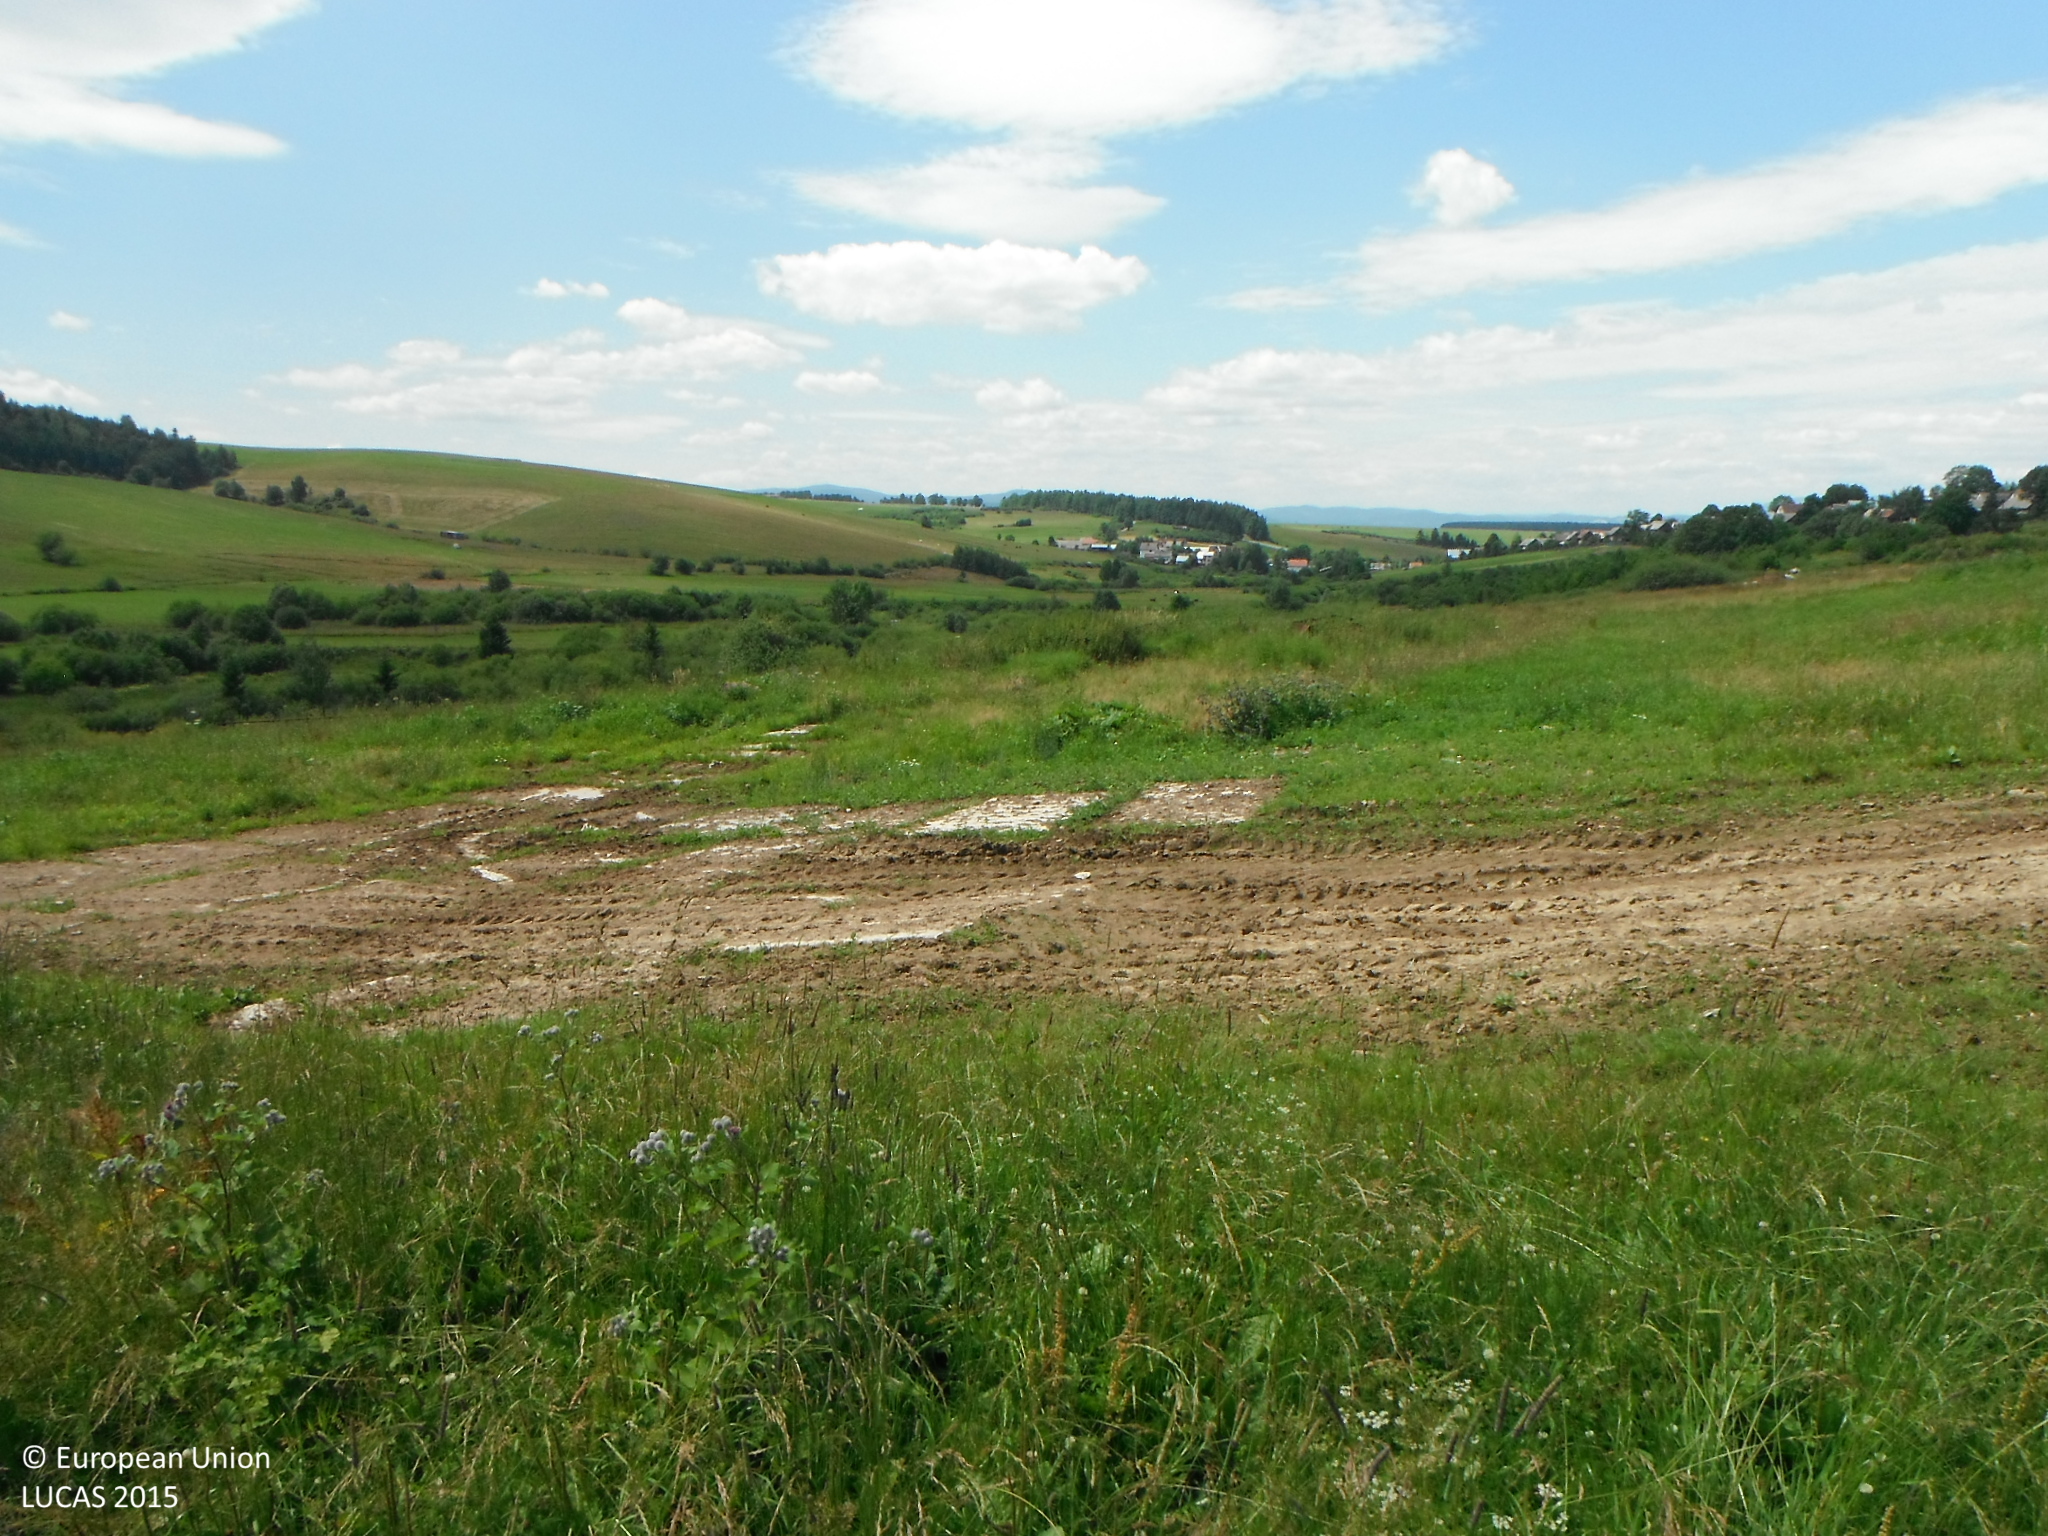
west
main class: Grassland
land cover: Grassland without tree/shrub cover
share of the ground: > 75 %
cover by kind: herbaceous plants 100 %
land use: Agriculture (excluding fallow land and kitchen gardens)
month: July
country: SK
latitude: 49.3656
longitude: 19.7645
